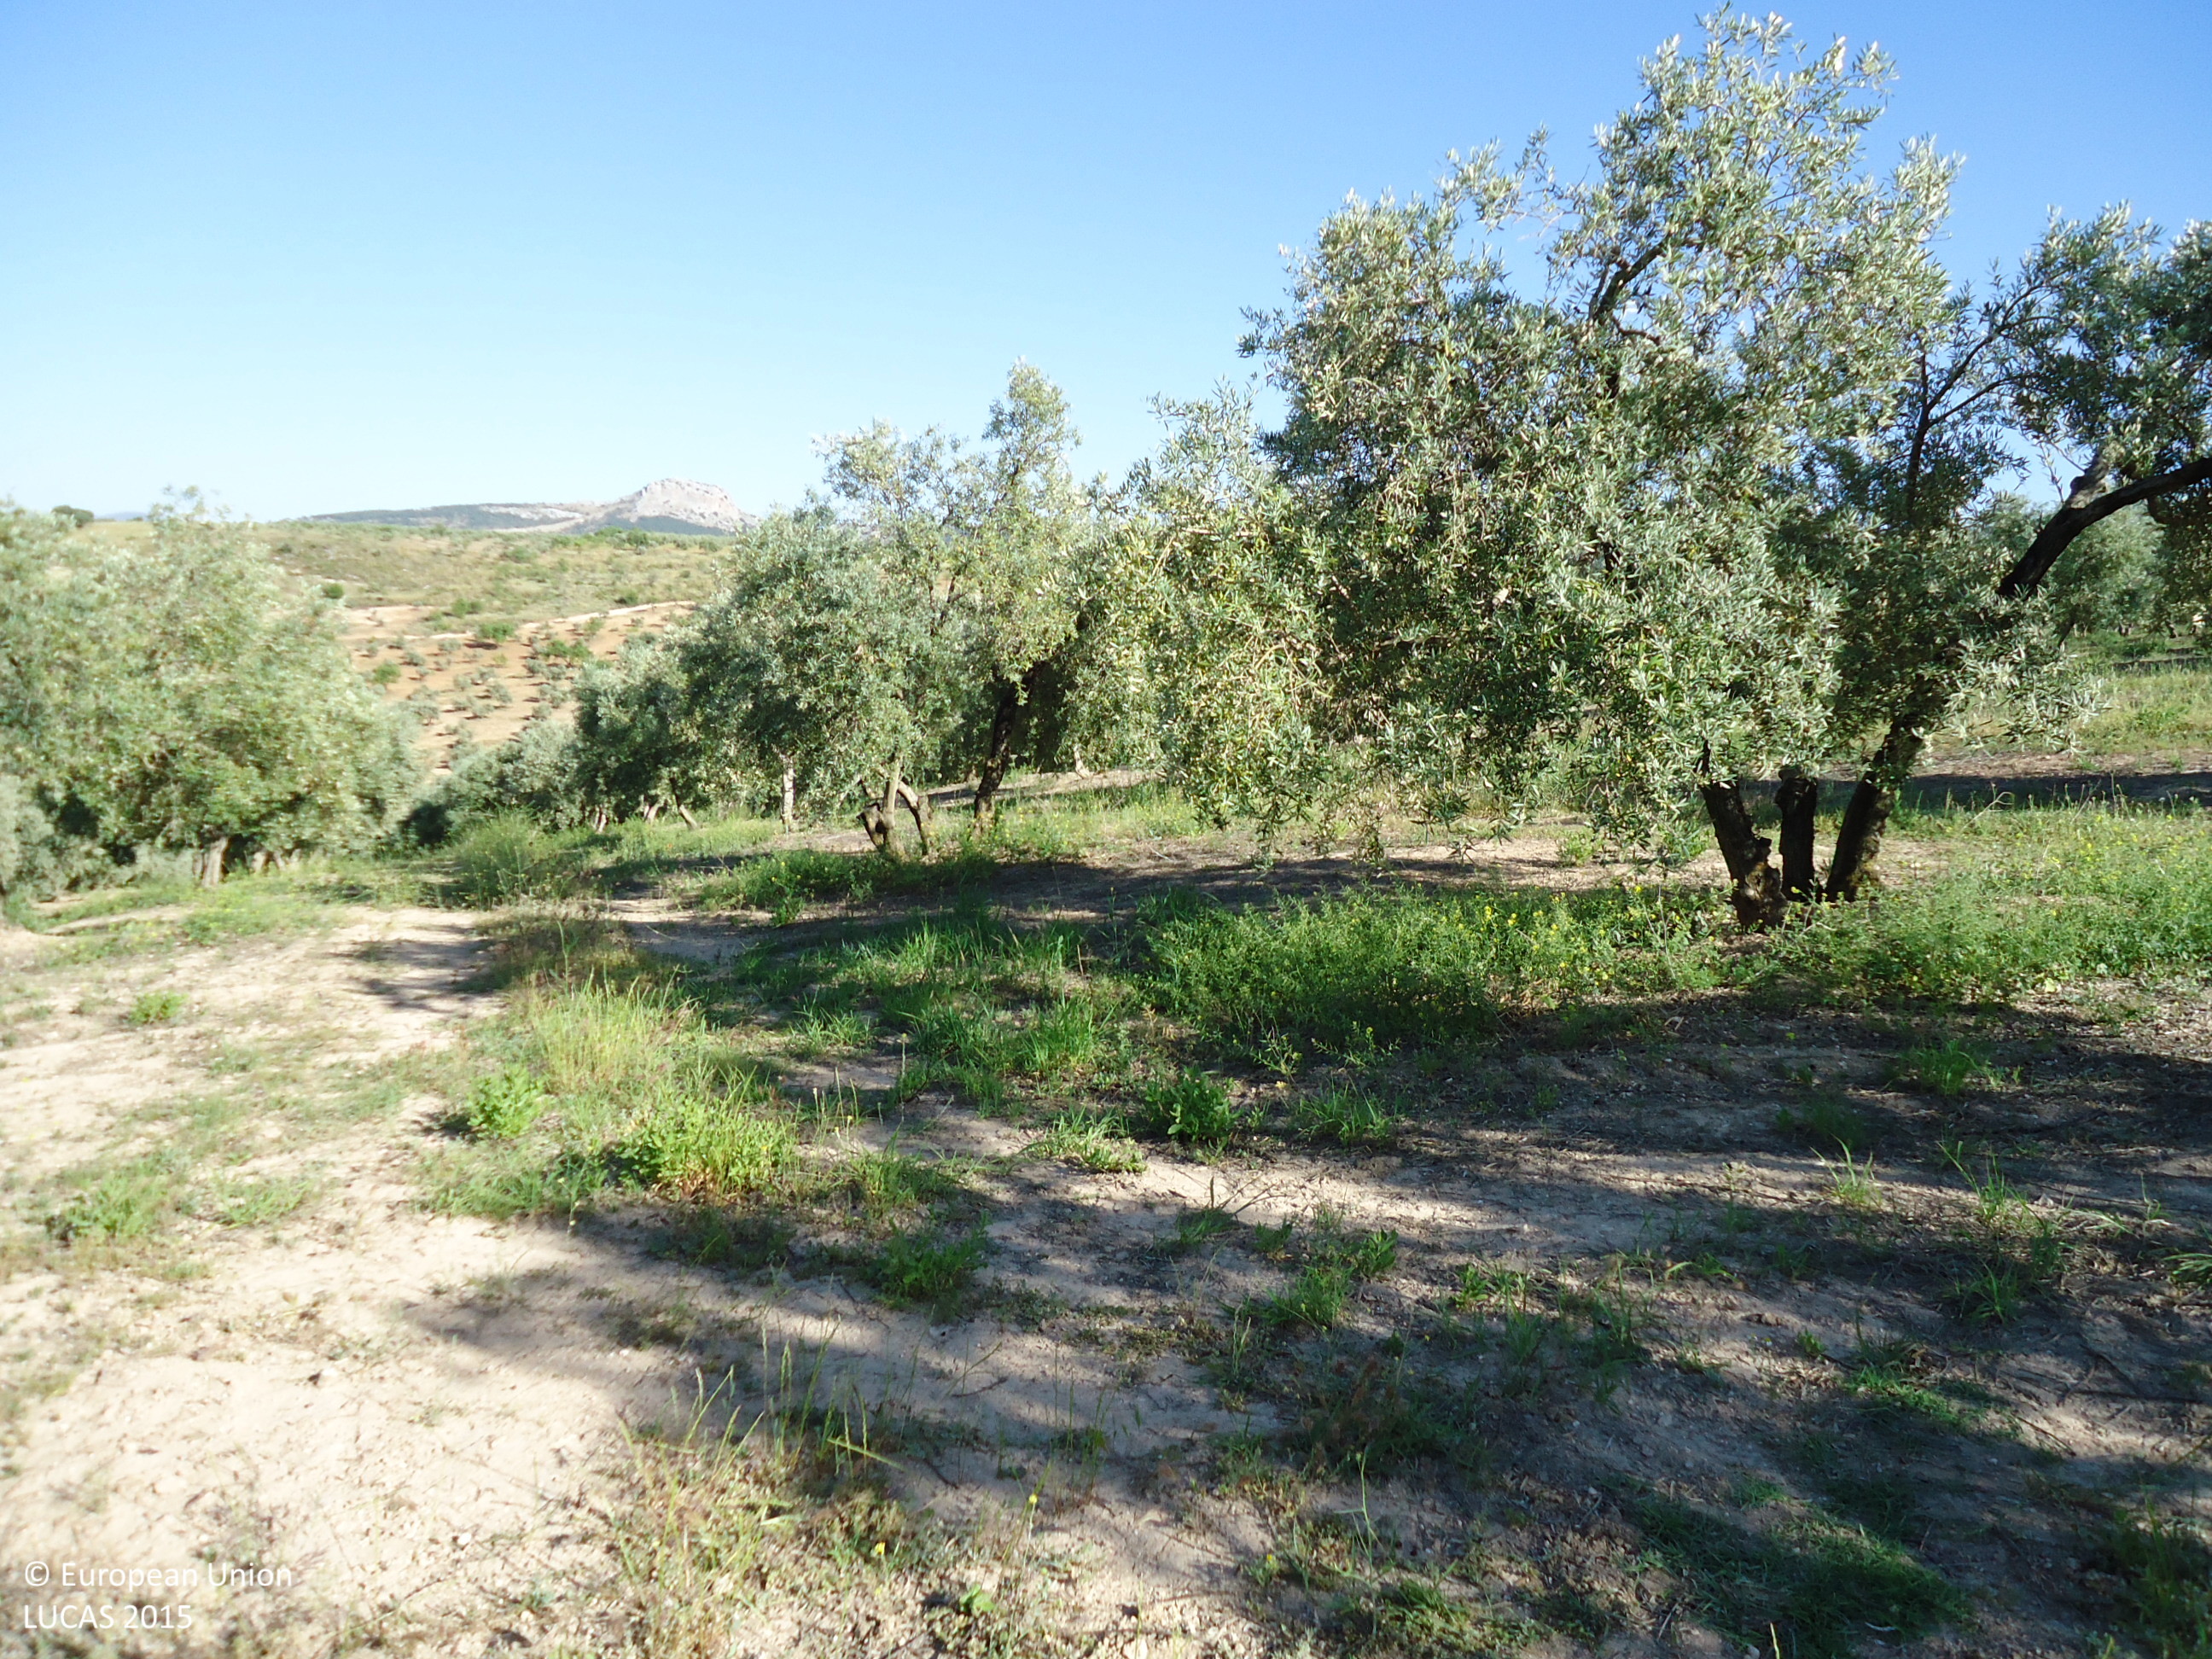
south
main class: Cropland
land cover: Olive groves
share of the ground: > 75 %
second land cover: Spontaneously vegetated surfaces
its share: 50 - 75 %
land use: Agriculture (excluding fallow land and kitchen gardens)
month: May
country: ES
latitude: 36.8817
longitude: -5.0004
